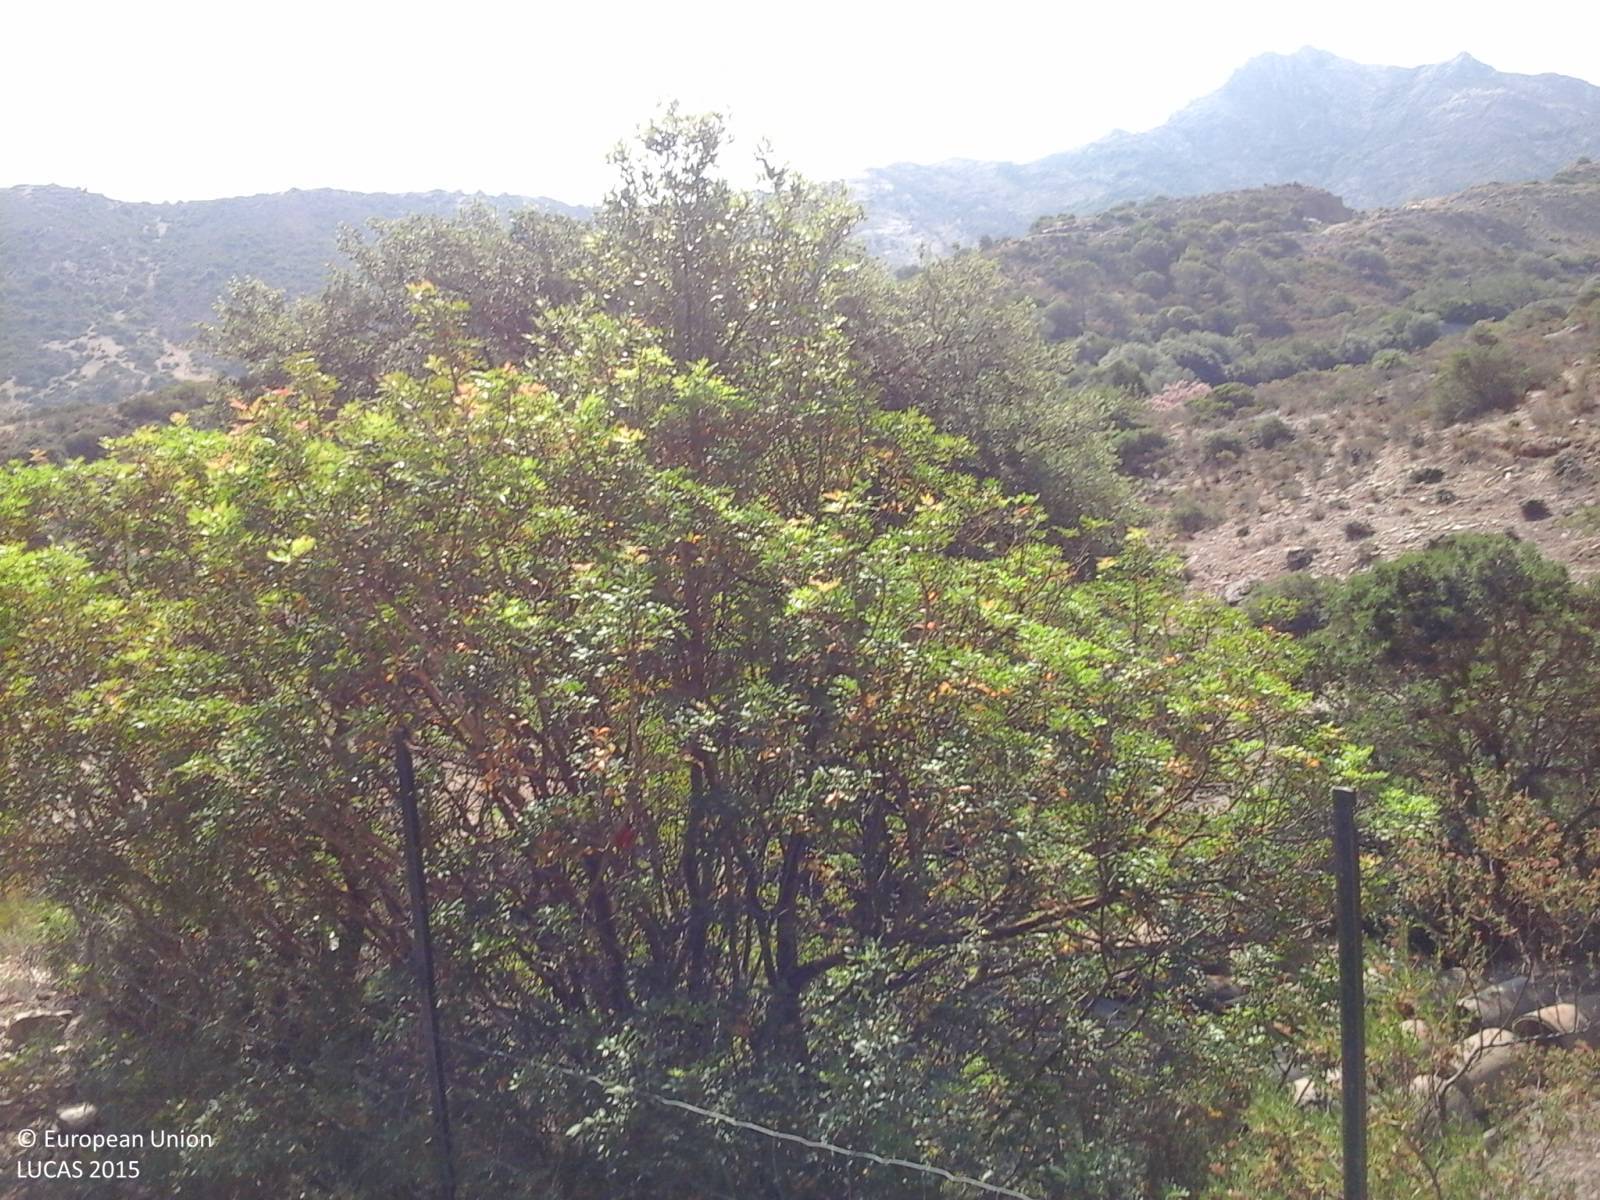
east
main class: Shrubland
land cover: Shrubland with sparse tree cover
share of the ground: > 75 %
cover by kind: shrubs 90 %, broadleaved forest trees 5 %, herbaceous plants 5 %
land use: Agriculture (excluding fallow land and kitchen gardens)
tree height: < 5 m
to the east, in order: Shrubland with sparse tree cover; Tracks; Shrubland with sparse tree cover; Tracks; Electric lines; Shrubland with sparse tree cover; Tracks; Shrubland with sparse tree cover; Olive groves; Tracks; Shrubland with sparse tree cover
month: July
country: IT
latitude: 39.4402
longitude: 8.4638
